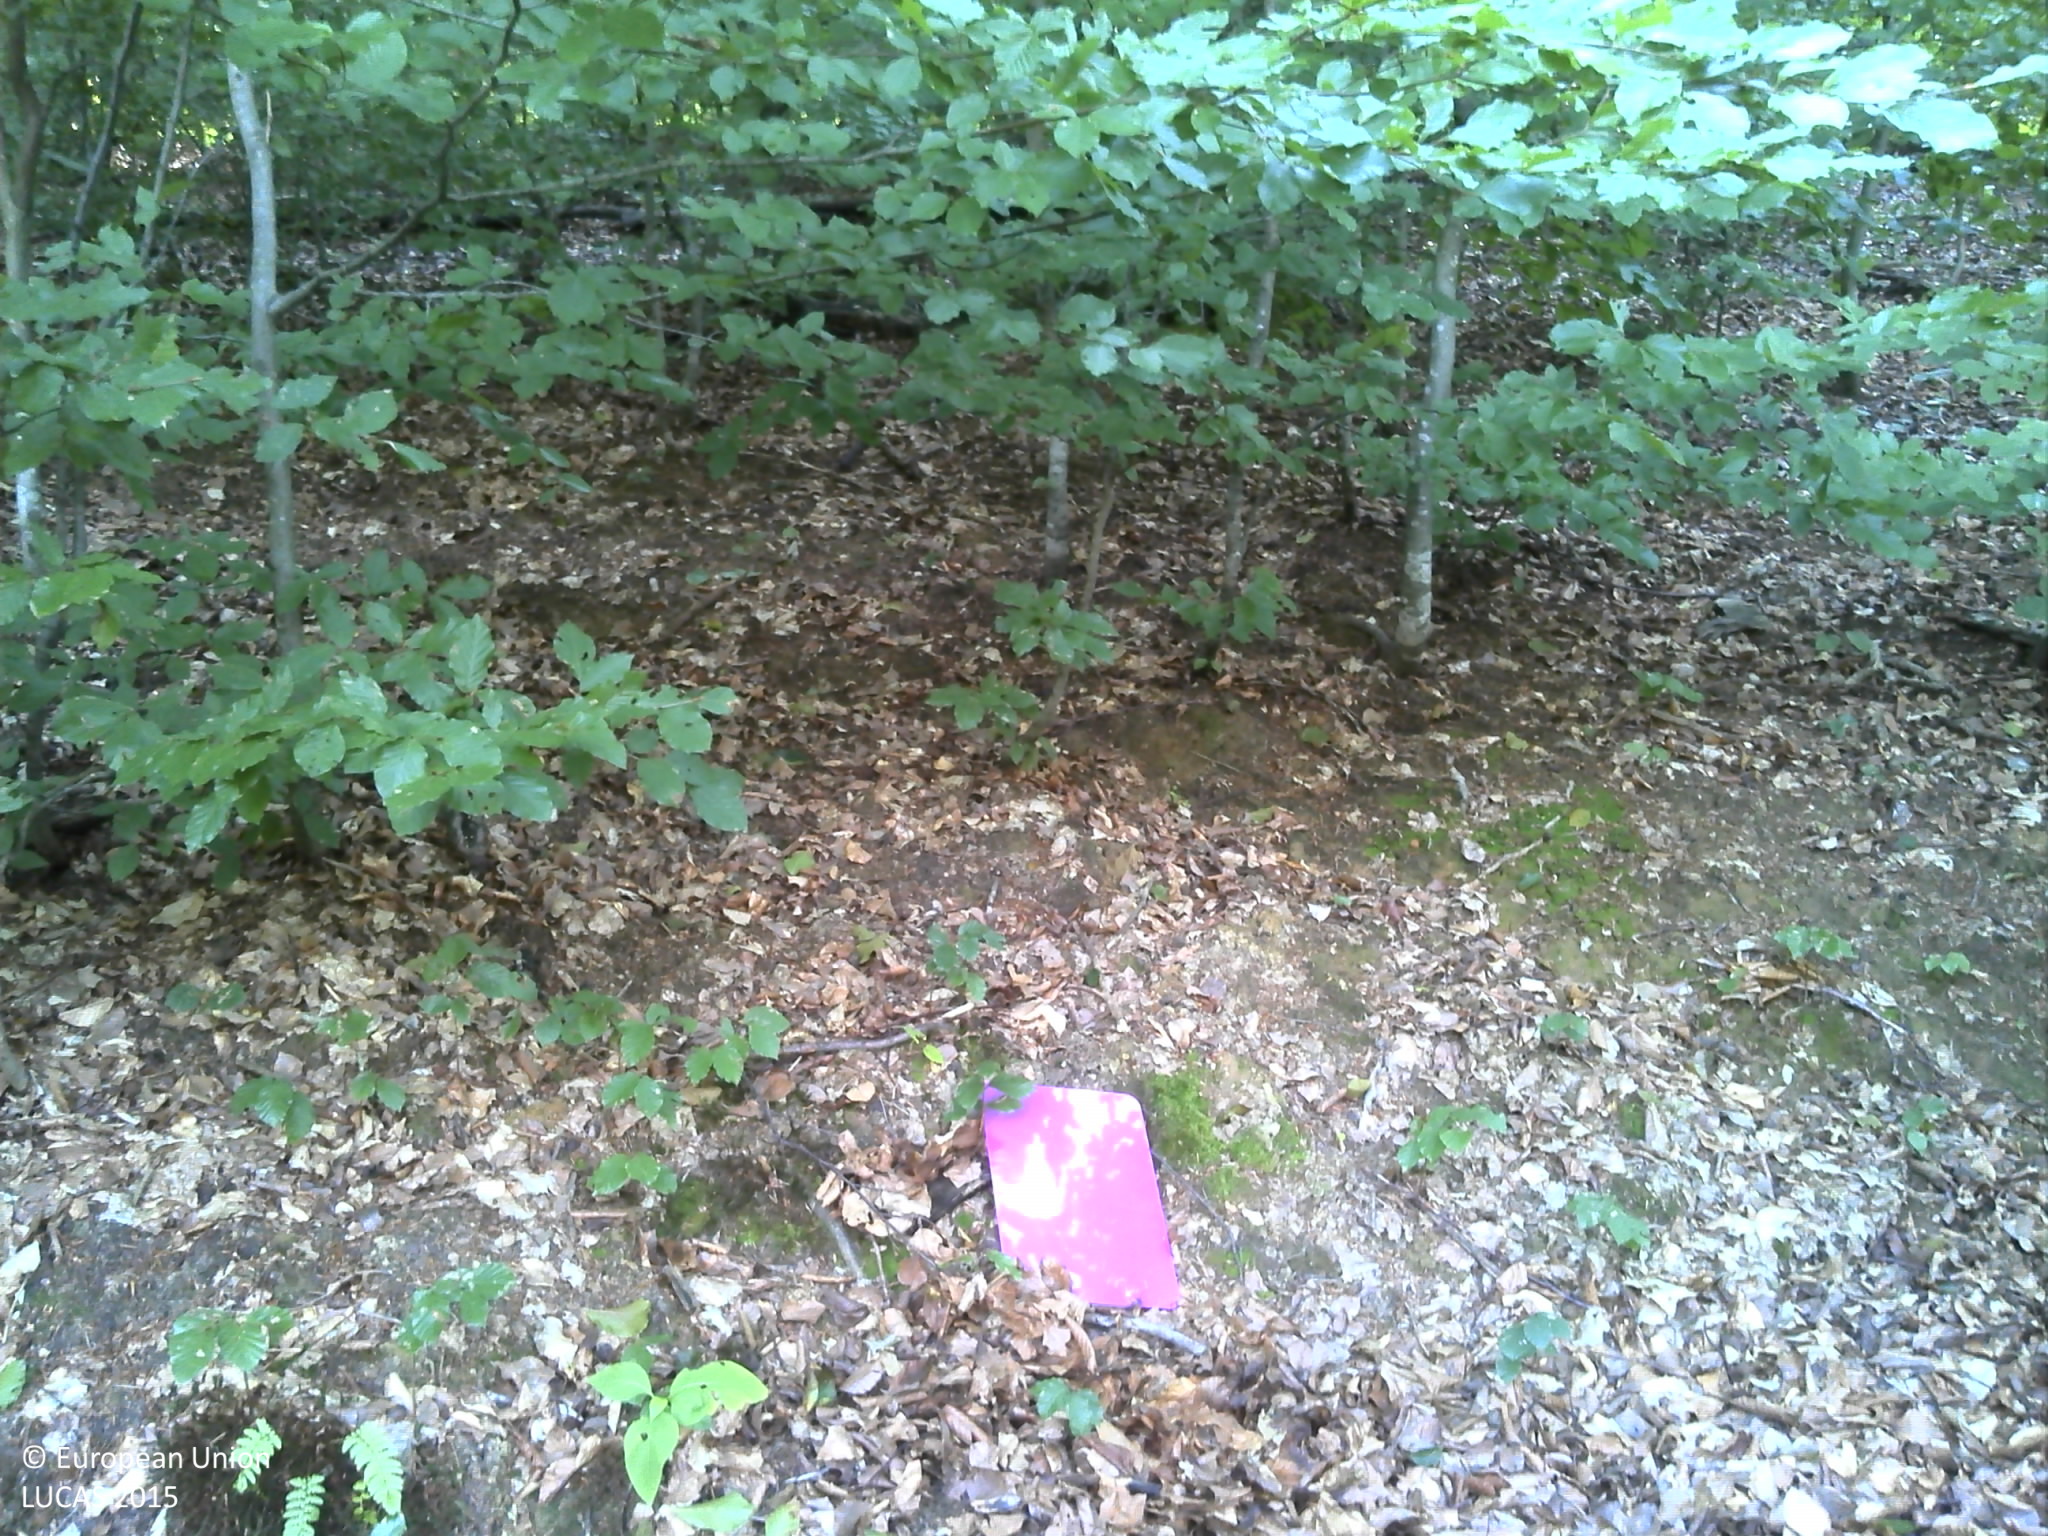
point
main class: Woodland
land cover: Broadleaved woodland
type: beech forest
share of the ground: > 75 %
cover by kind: broadleaved forest trees 100 %
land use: Forestry
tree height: > 5 m
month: August
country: HR
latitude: 45.2213
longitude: 16.0709
